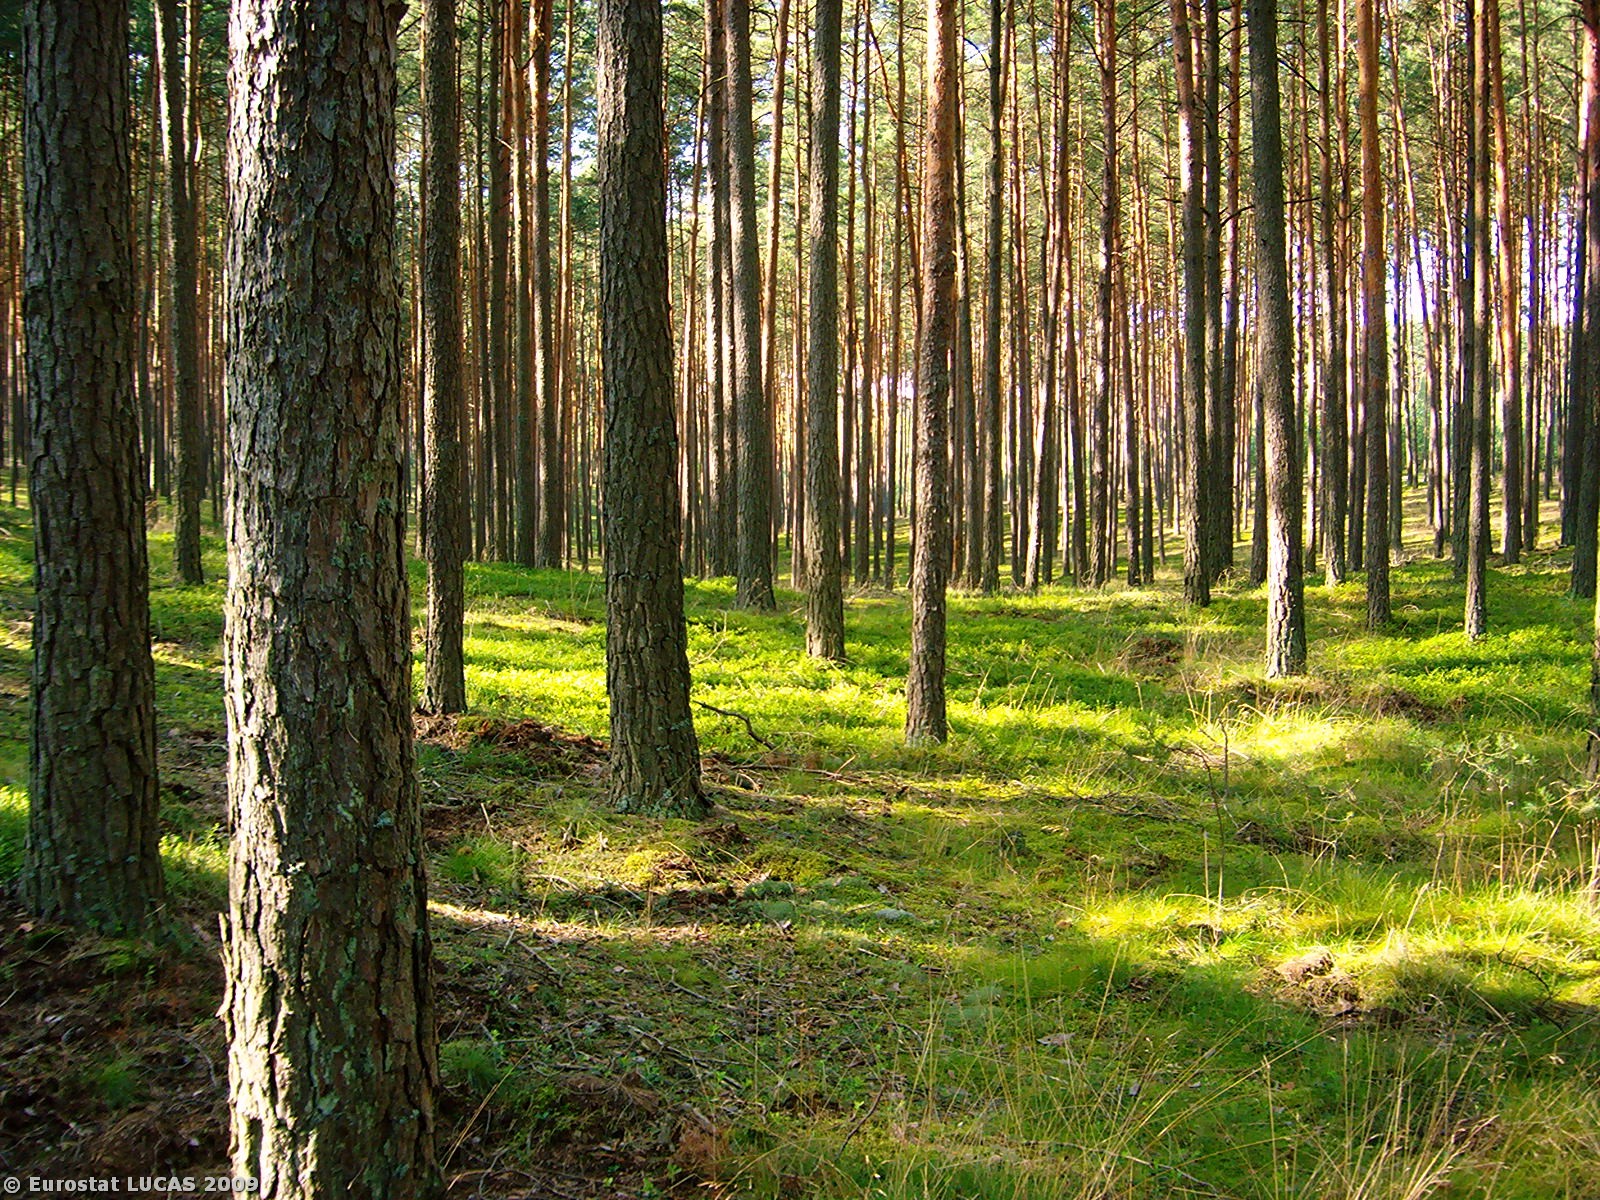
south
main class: Woodland
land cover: Coniferous woodland
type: hemiboreal forest and nemoral coniferous forest and mixed broadleaved-coniferous forest
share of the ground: 50 - 75 %
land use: Forestry
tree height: > 5 m
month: August
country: PL
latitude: 52.8794
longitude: 15.9041
